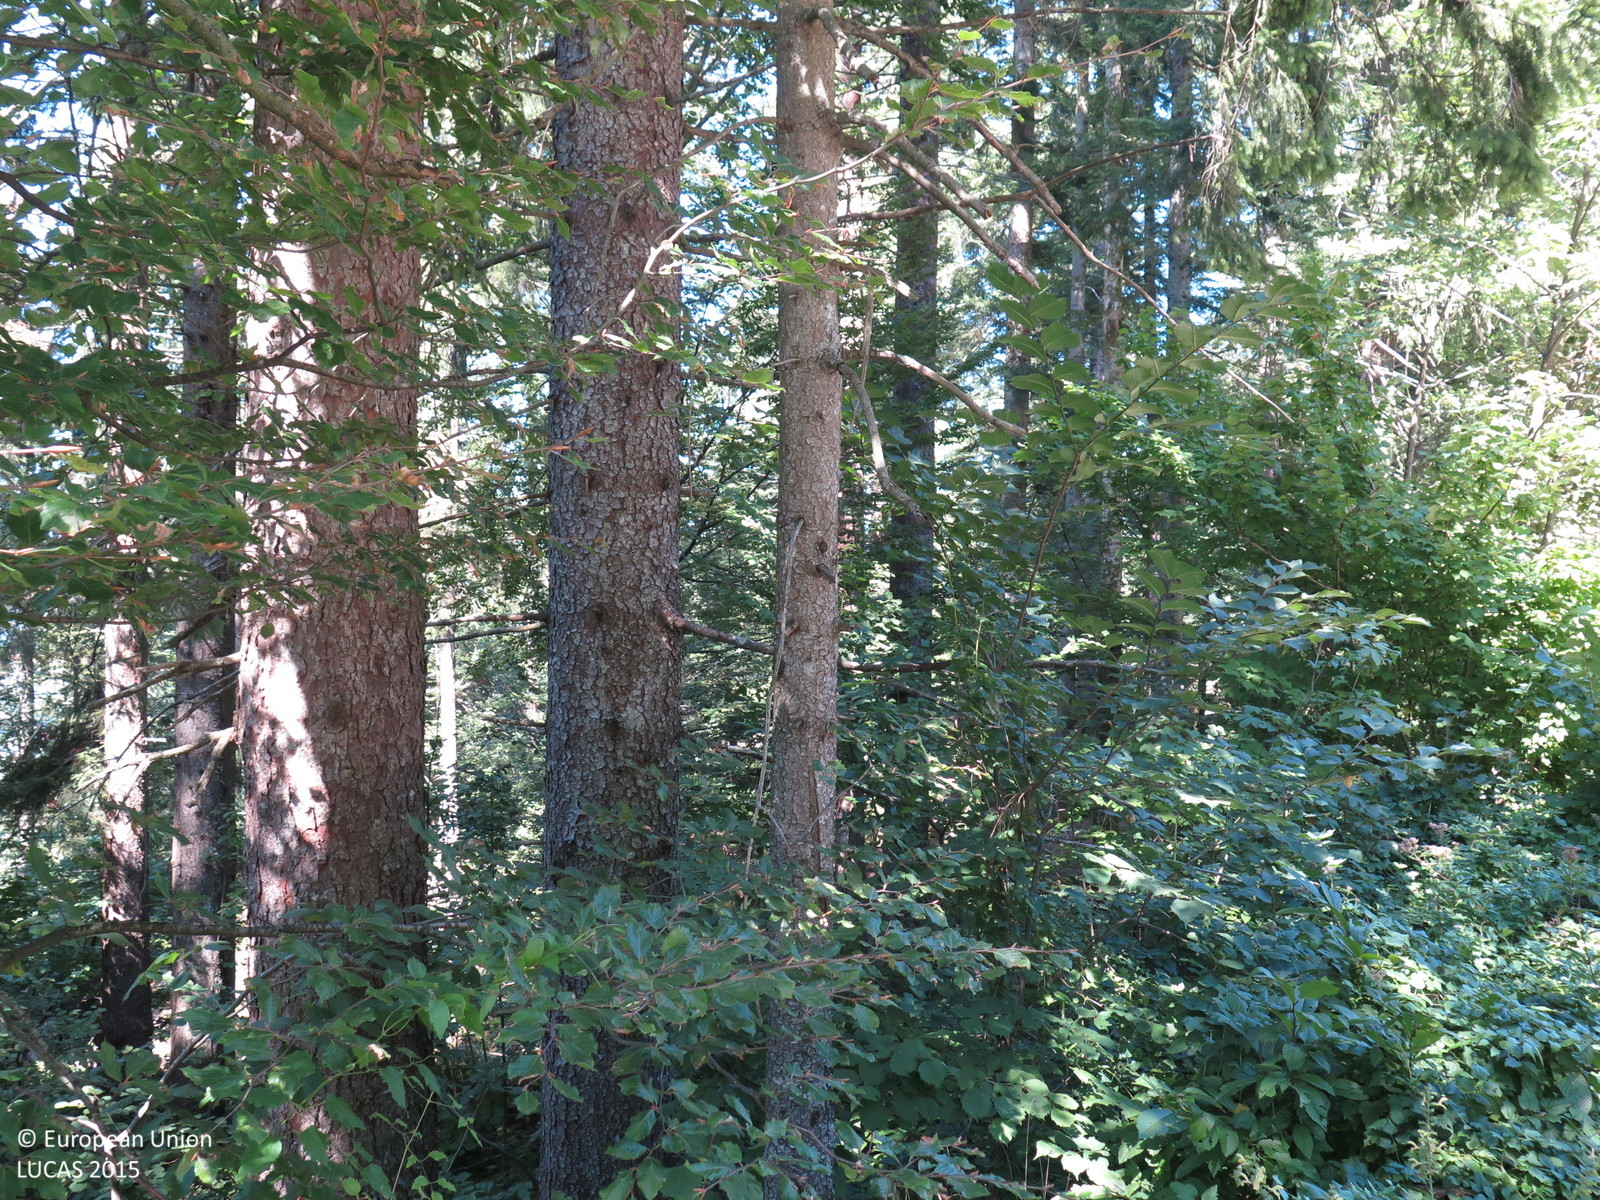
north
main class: Woodland
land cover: Other mixed woodland
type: mountainous beech forest
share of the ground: > 75 %
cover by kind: coniferous forest trees 75 %, broadleaved forest trees 25 %
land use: Forestry
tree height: > 5 m
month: August
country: HR
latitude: 45.3431
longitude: 14.7554
